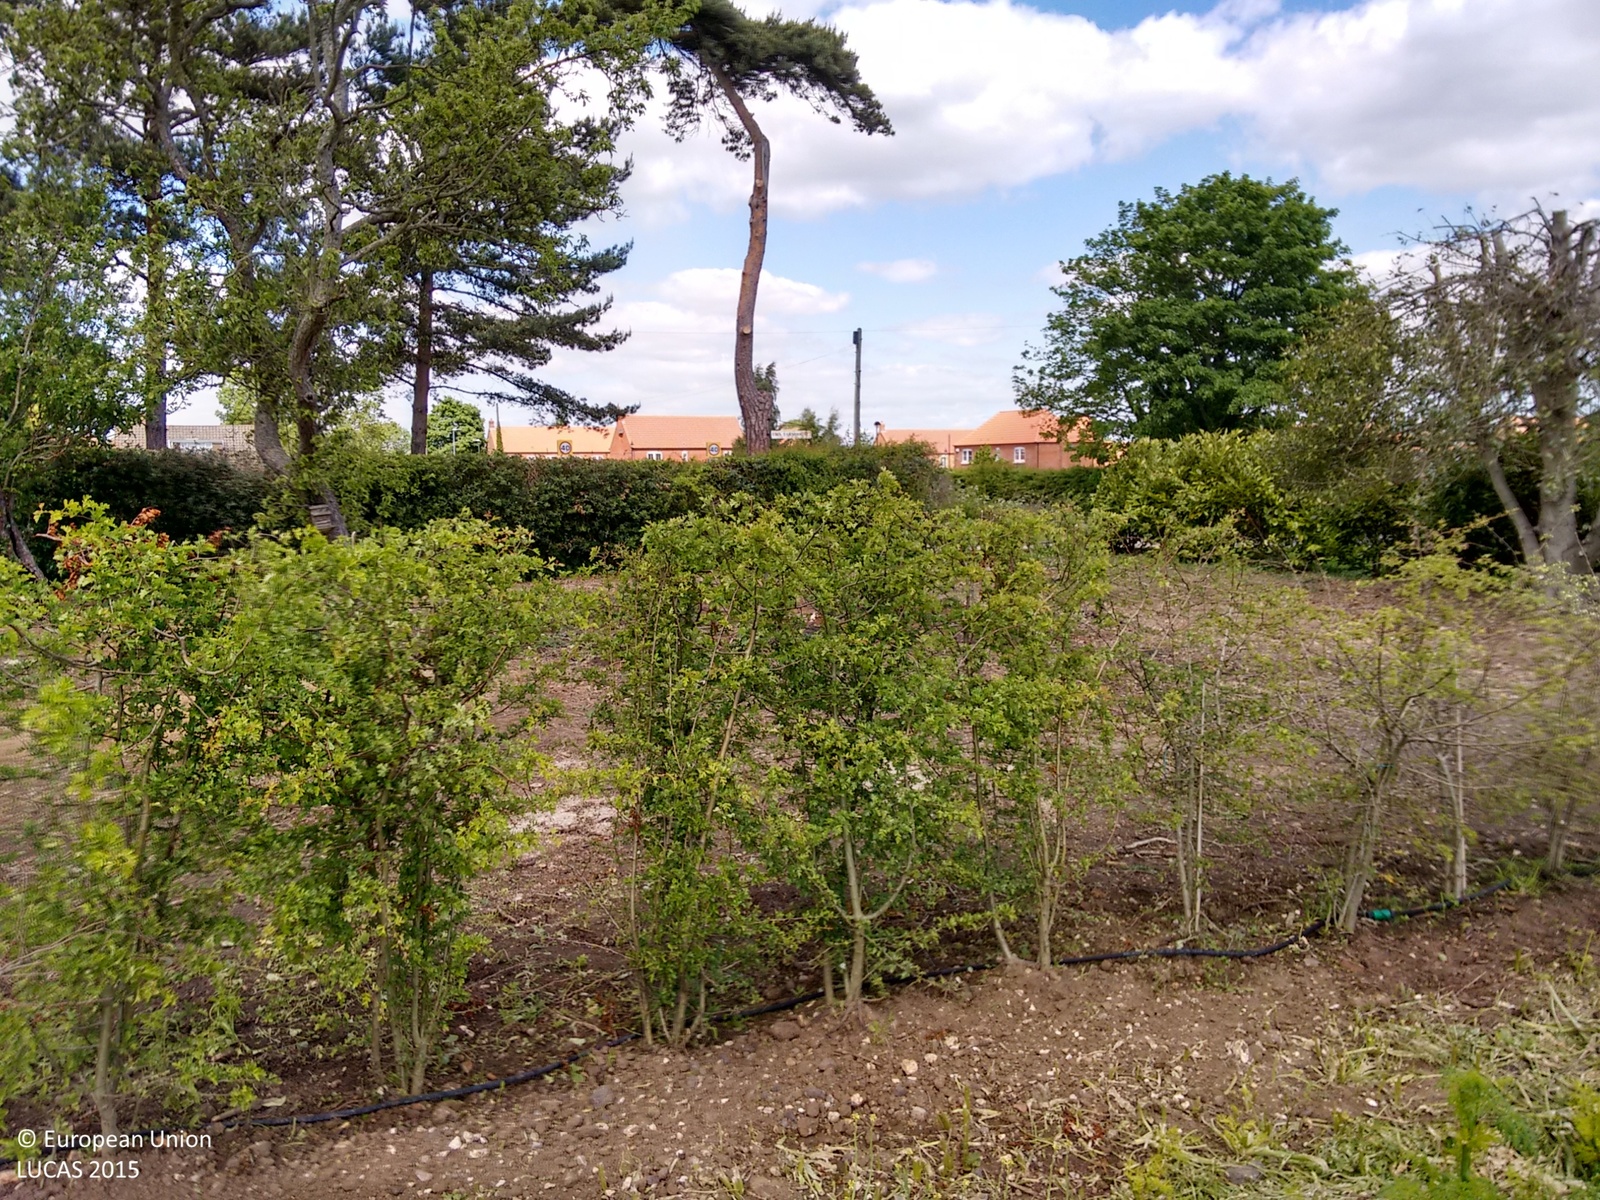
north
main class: Cropland
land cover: Rape and turnip rape
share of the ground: > 75 %
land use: Agriculture (excluding fallow land and kitchen gardens)
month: June
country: GB
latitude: 53.5051
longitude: -0.0892
